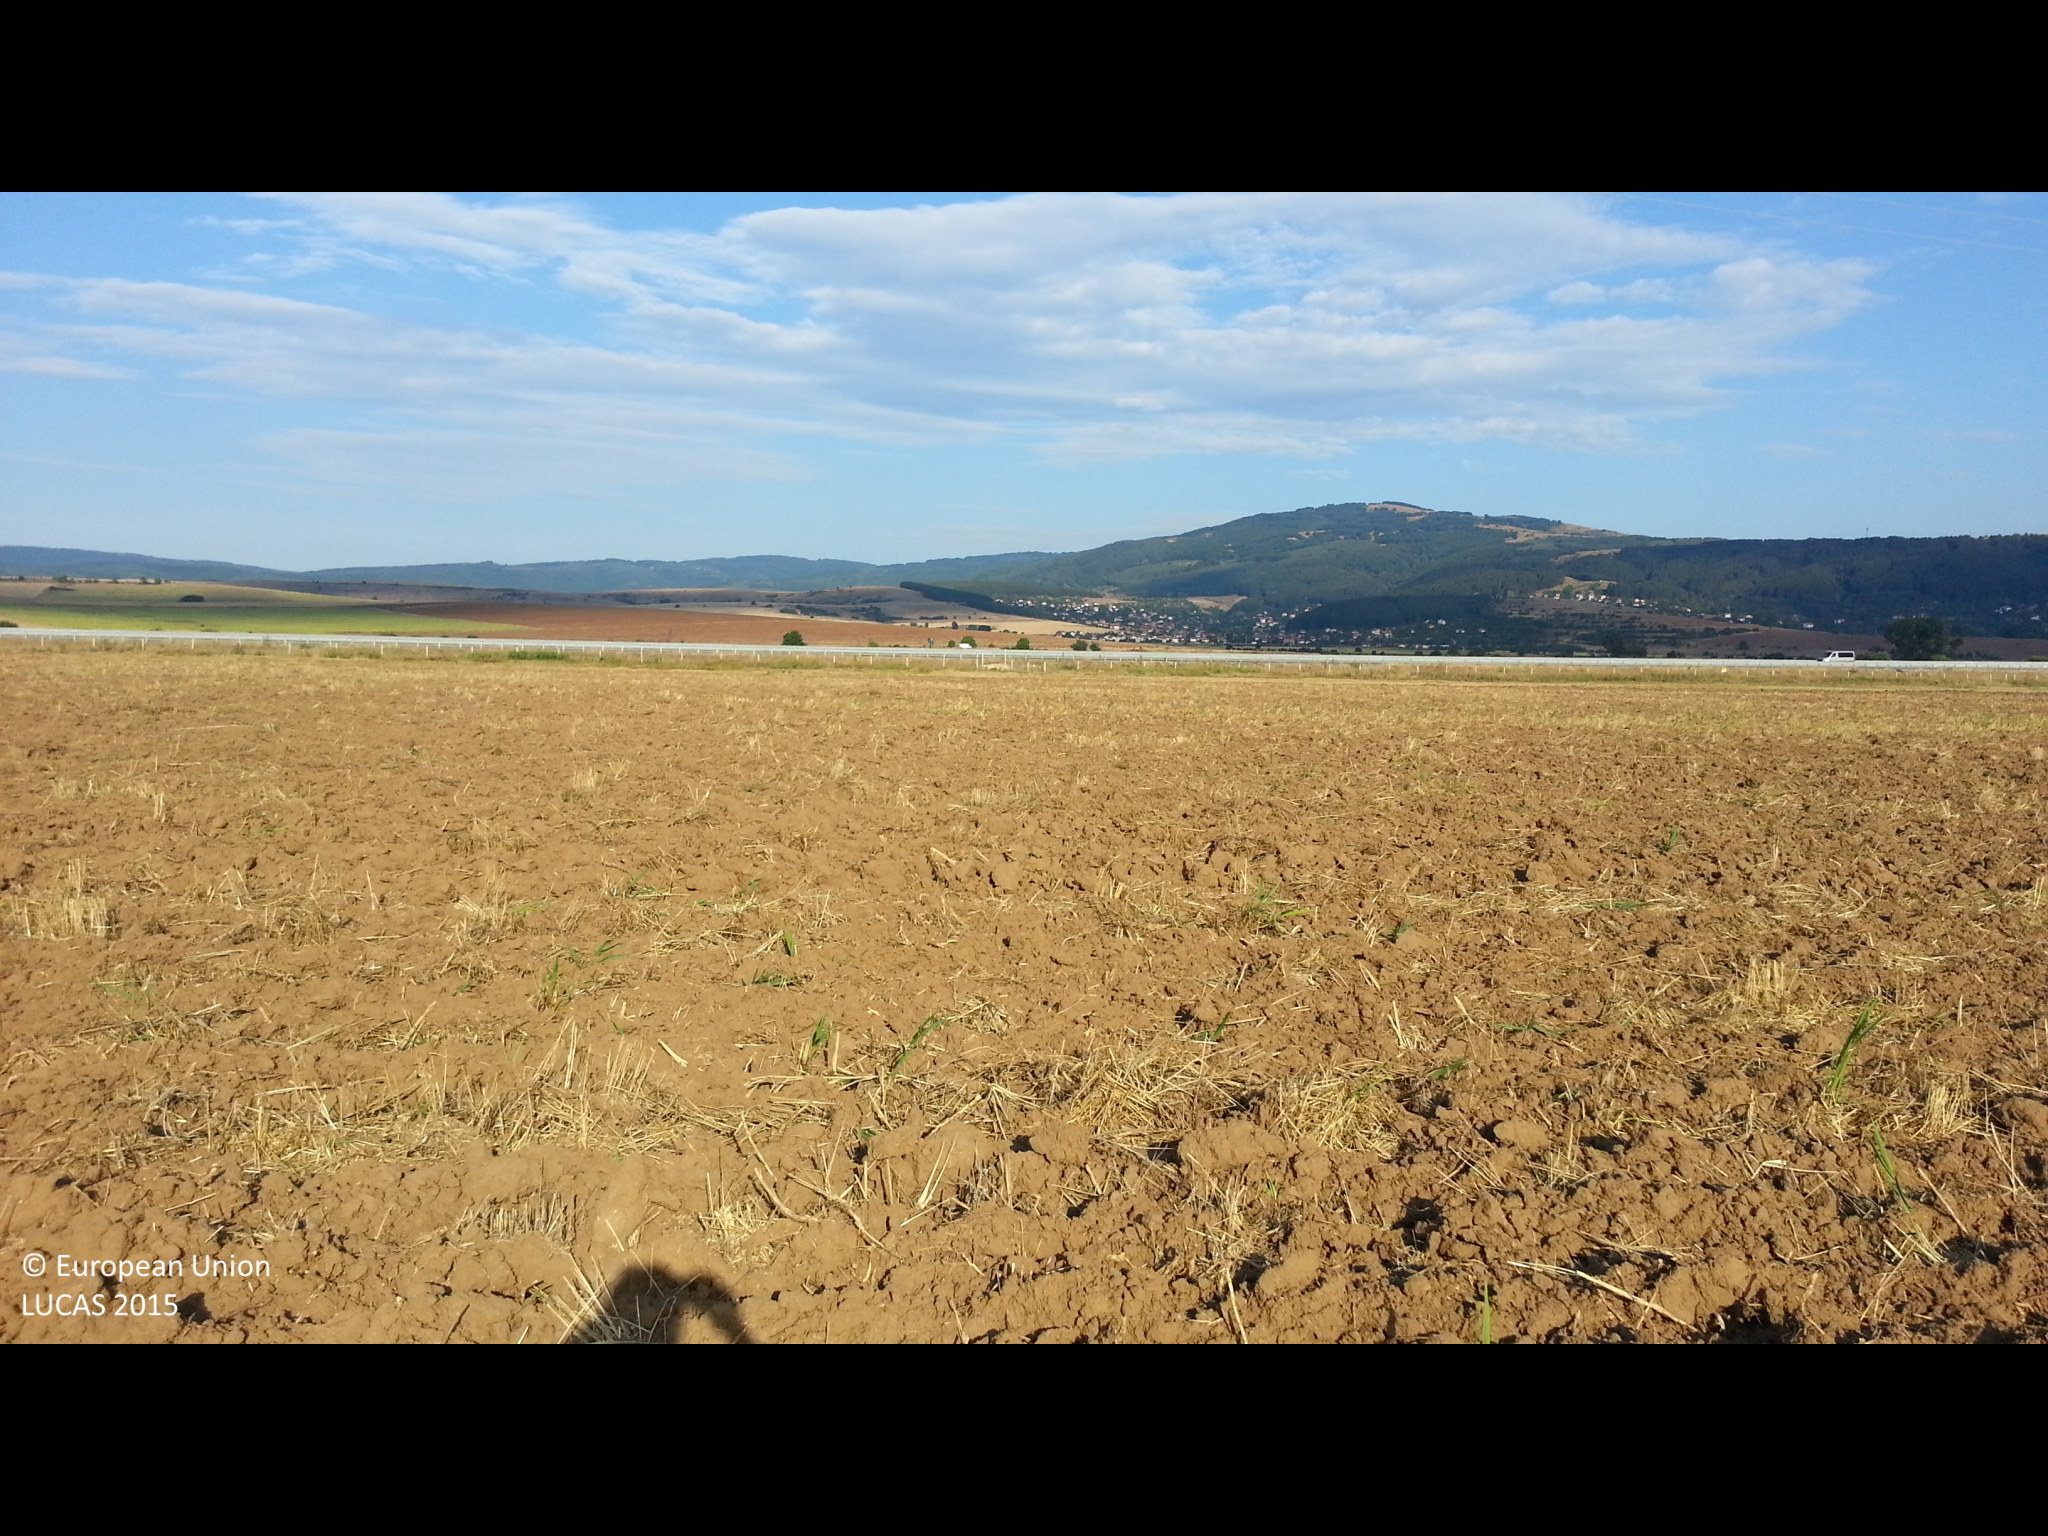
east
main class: Cropland
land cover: Common wheat
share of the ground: < 10 %
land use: Agriculture (excluding fallow land and kitchen gardens)
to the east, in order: Common wheat; Spontaneously vegetated surfaces; Grass margins; Fences; Ditches and canals; Paved roads, cycling and walking lanes; Ditches and canals; Fences; Grass margins; Other bare soil
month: August
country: BG
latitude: 42.4181
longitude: 23.1171
